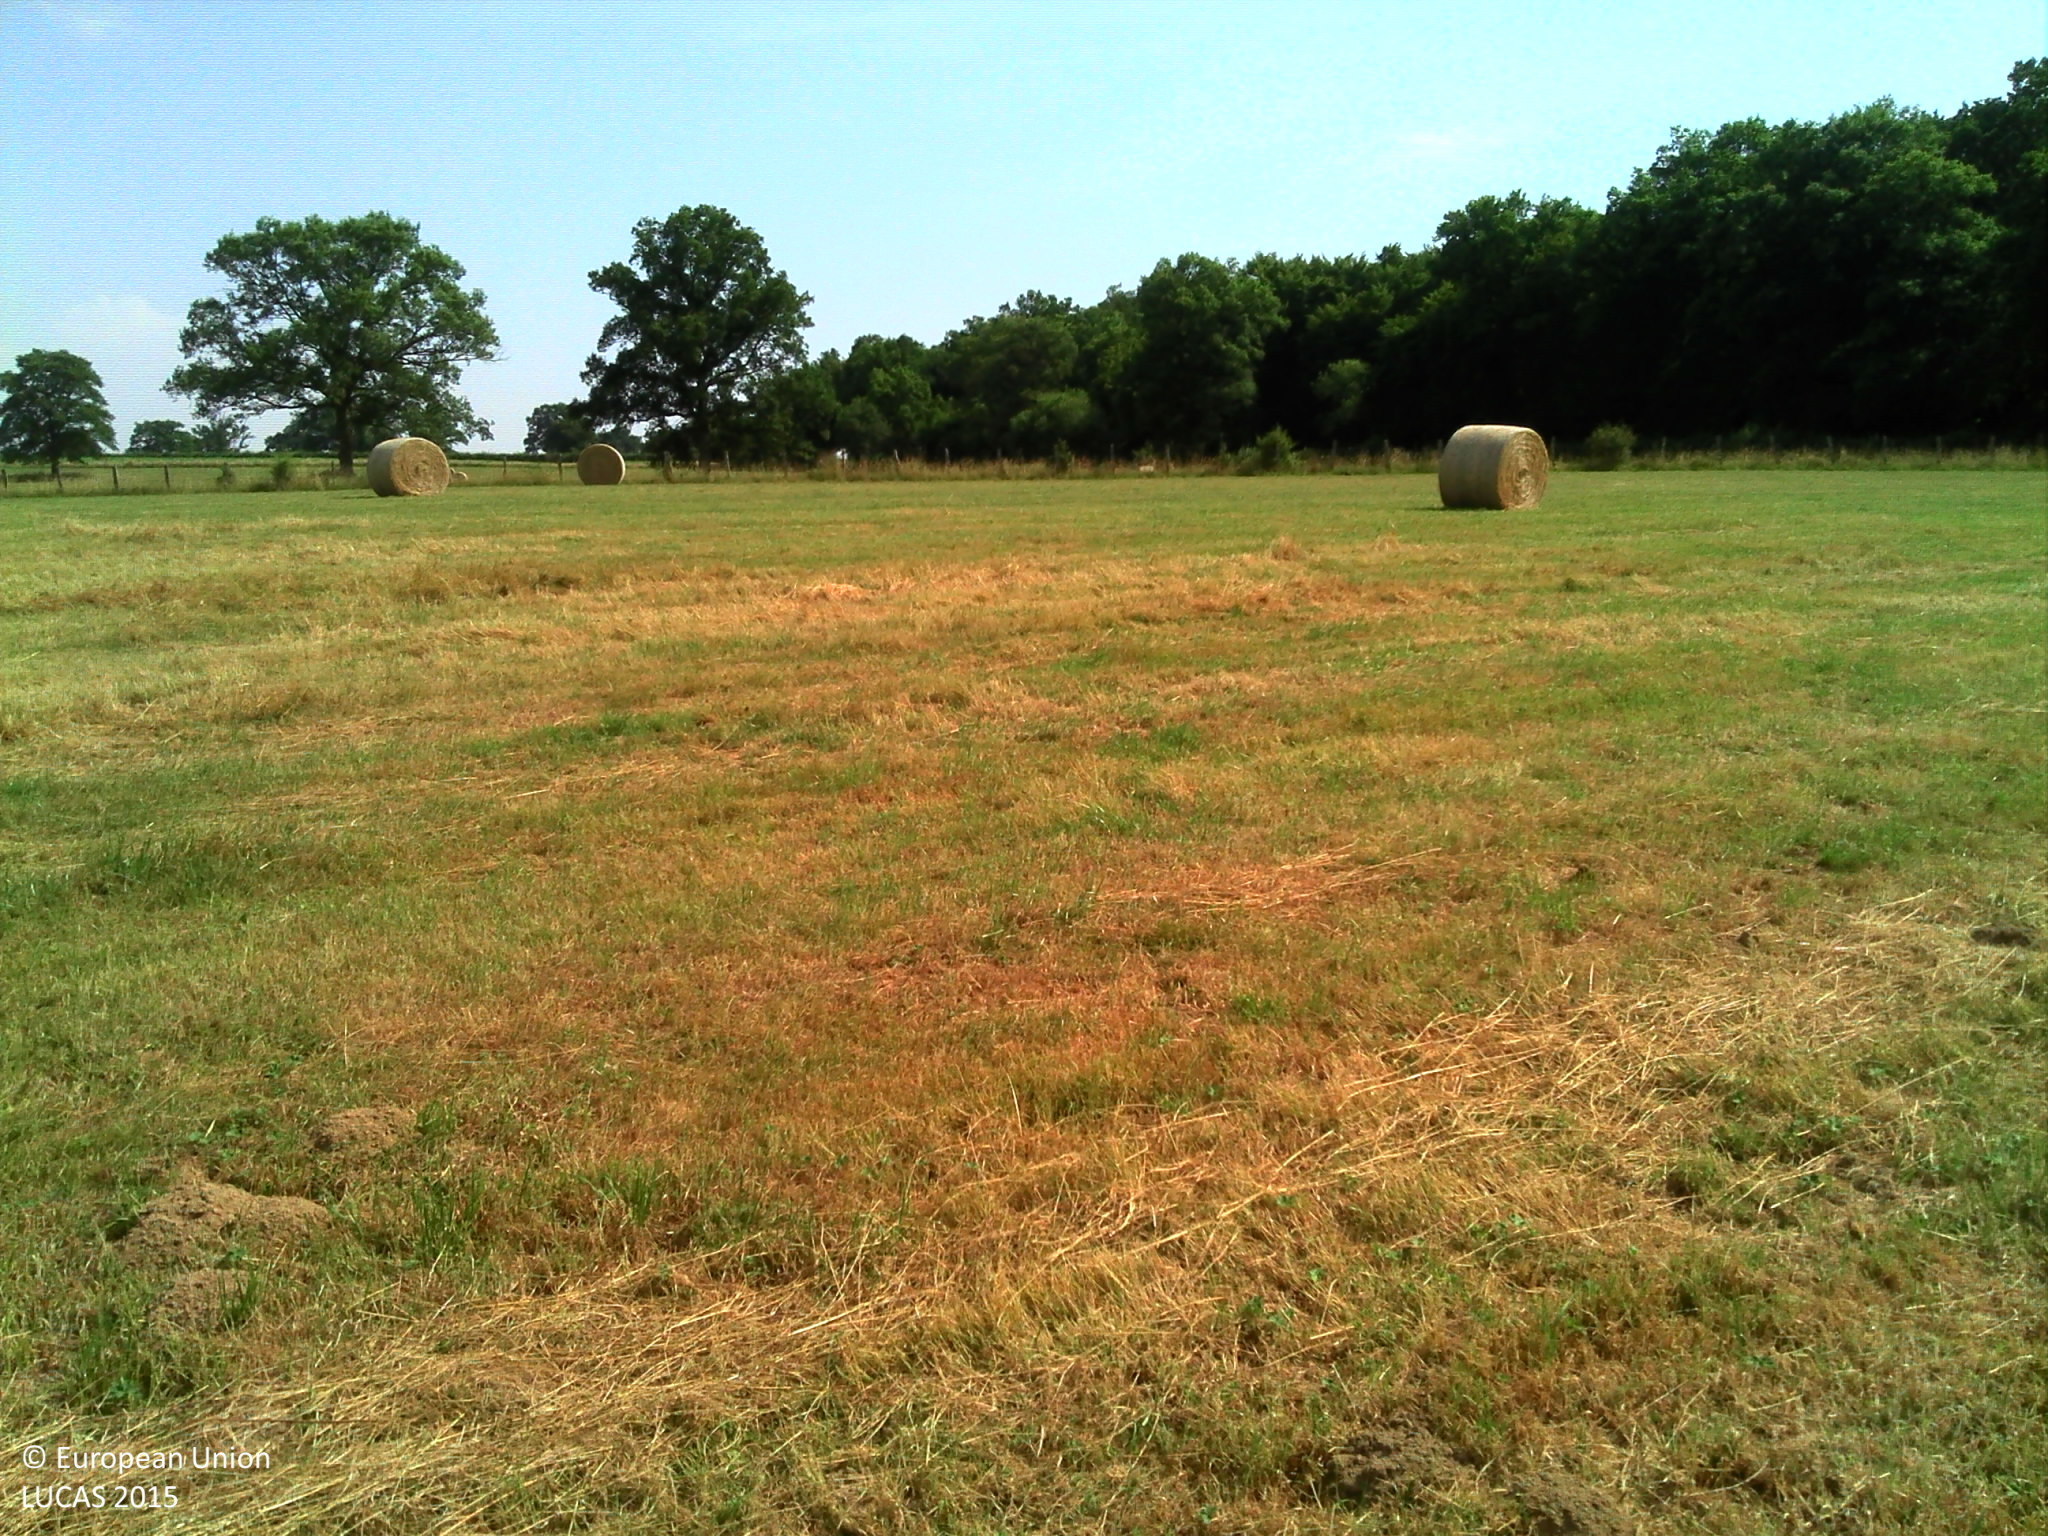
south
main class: Grassland
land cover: Grassland without tree/shrub cover
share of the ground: > 75 %
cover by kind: herbaceous plants 100 %
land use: Agriculture (excluding fallow land and kitchen gardens)
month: July
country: FR
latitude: 47.2379
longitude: 3.5109
